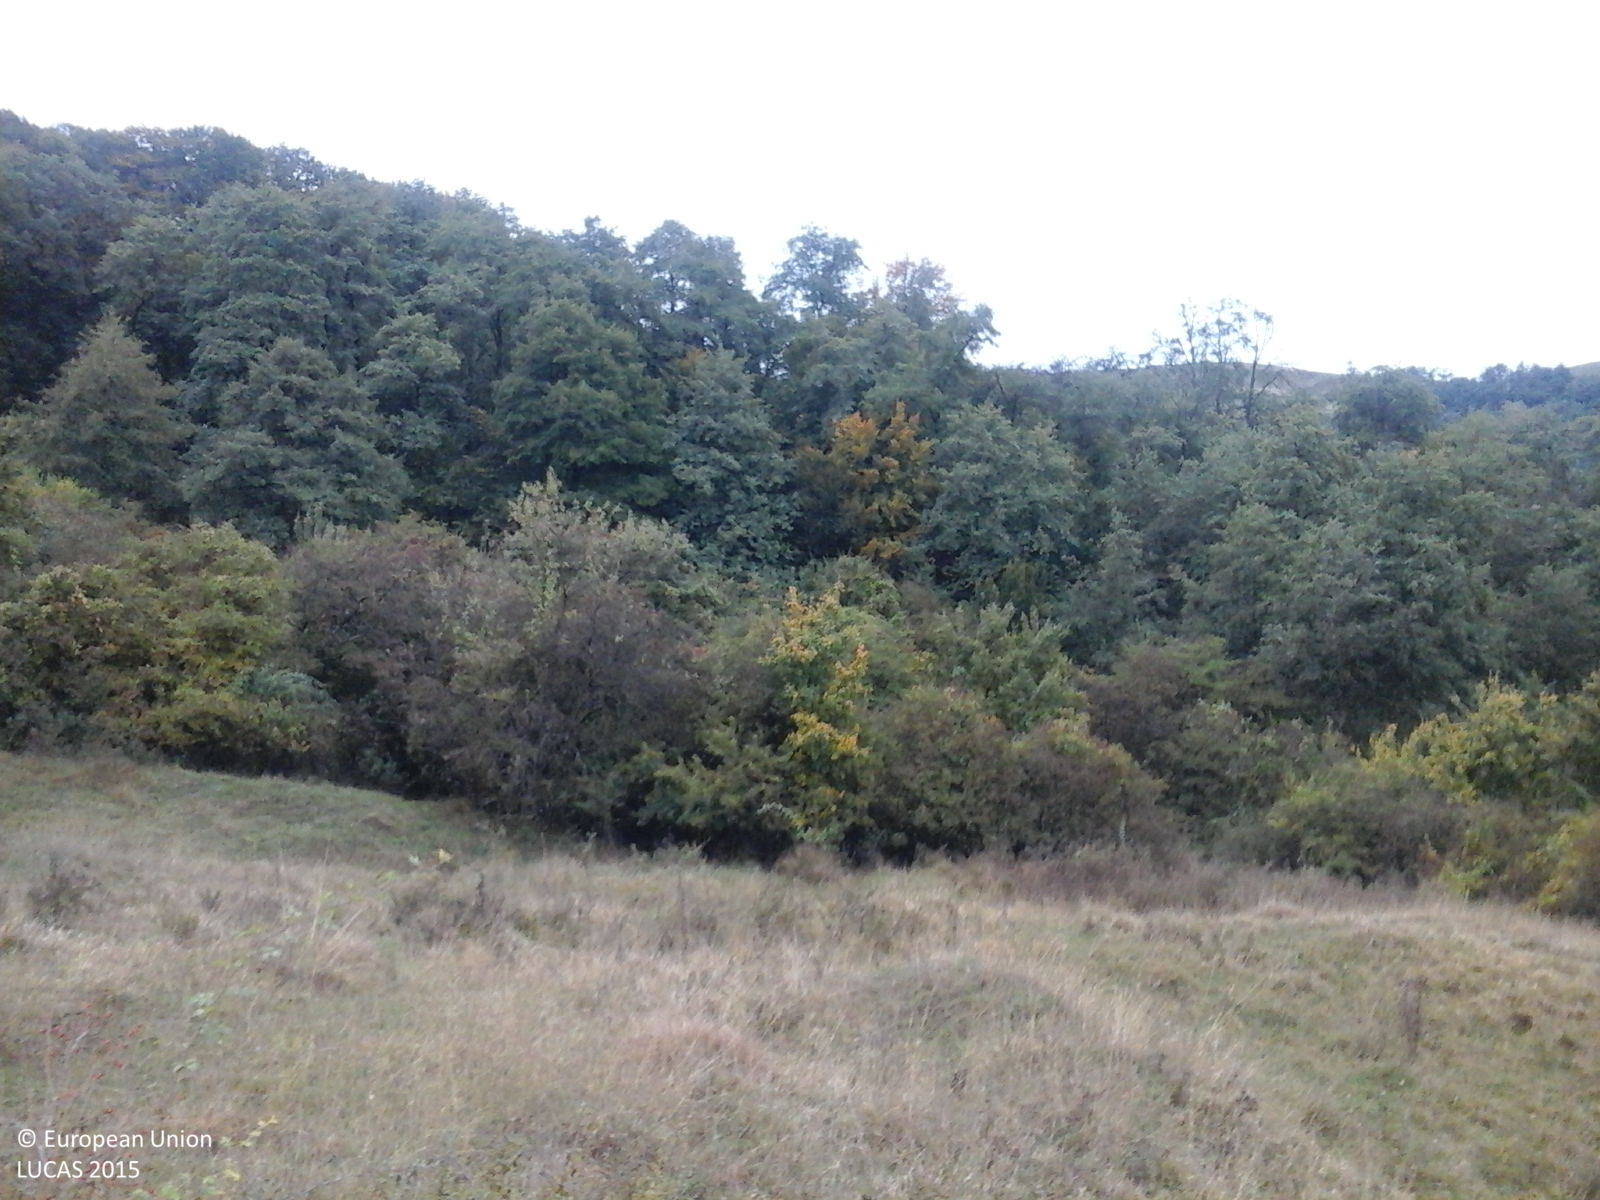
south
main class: Grassland
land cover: Grassland with sparse tree/shrub cover
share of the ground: > 75 %
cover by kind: herbaceous plants 85 %, shrubs 10 %, broadleaved forest trees 5 %
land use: Agriculture (excluding fallow land and kitchen gardens)
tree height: < 5 m
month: October
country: RO
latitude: 46.0518
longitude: 24.2306
